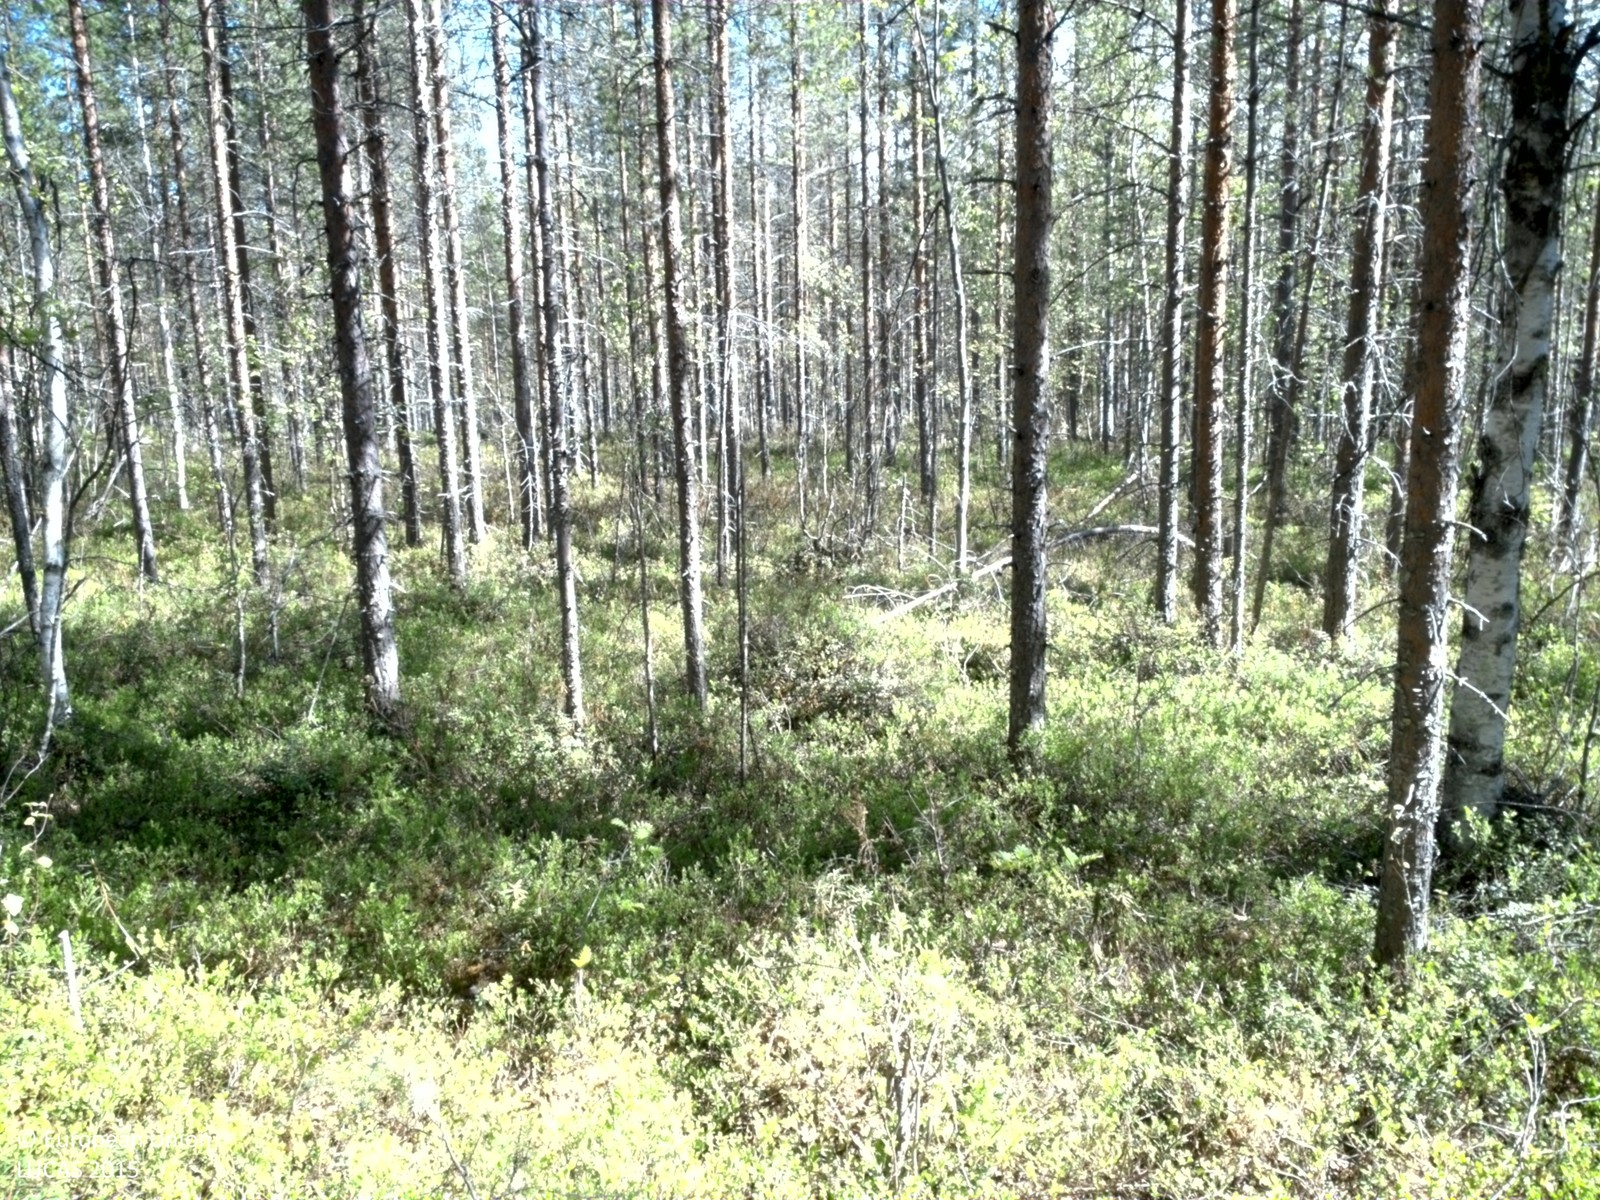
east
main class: Woodland
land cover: Pine dominated coniferous woodland
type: boreal forest
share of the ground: 50 - 75 %
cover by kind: coniferous forest trees 60 %, shrubs 30 %, broadleaved forest trees 10 %
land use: Forestry
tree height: > 5 m
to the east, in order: Pine dominated coniferous woodland; Groves; Ditches and canals; Paved roads, cycling and walking lanes; Groves; Spruce dominated mixed woodland; Broadleaved woodland; Pine dominated mixed woodland
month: June
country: SE
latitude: 66.5925
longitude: 22.3531
